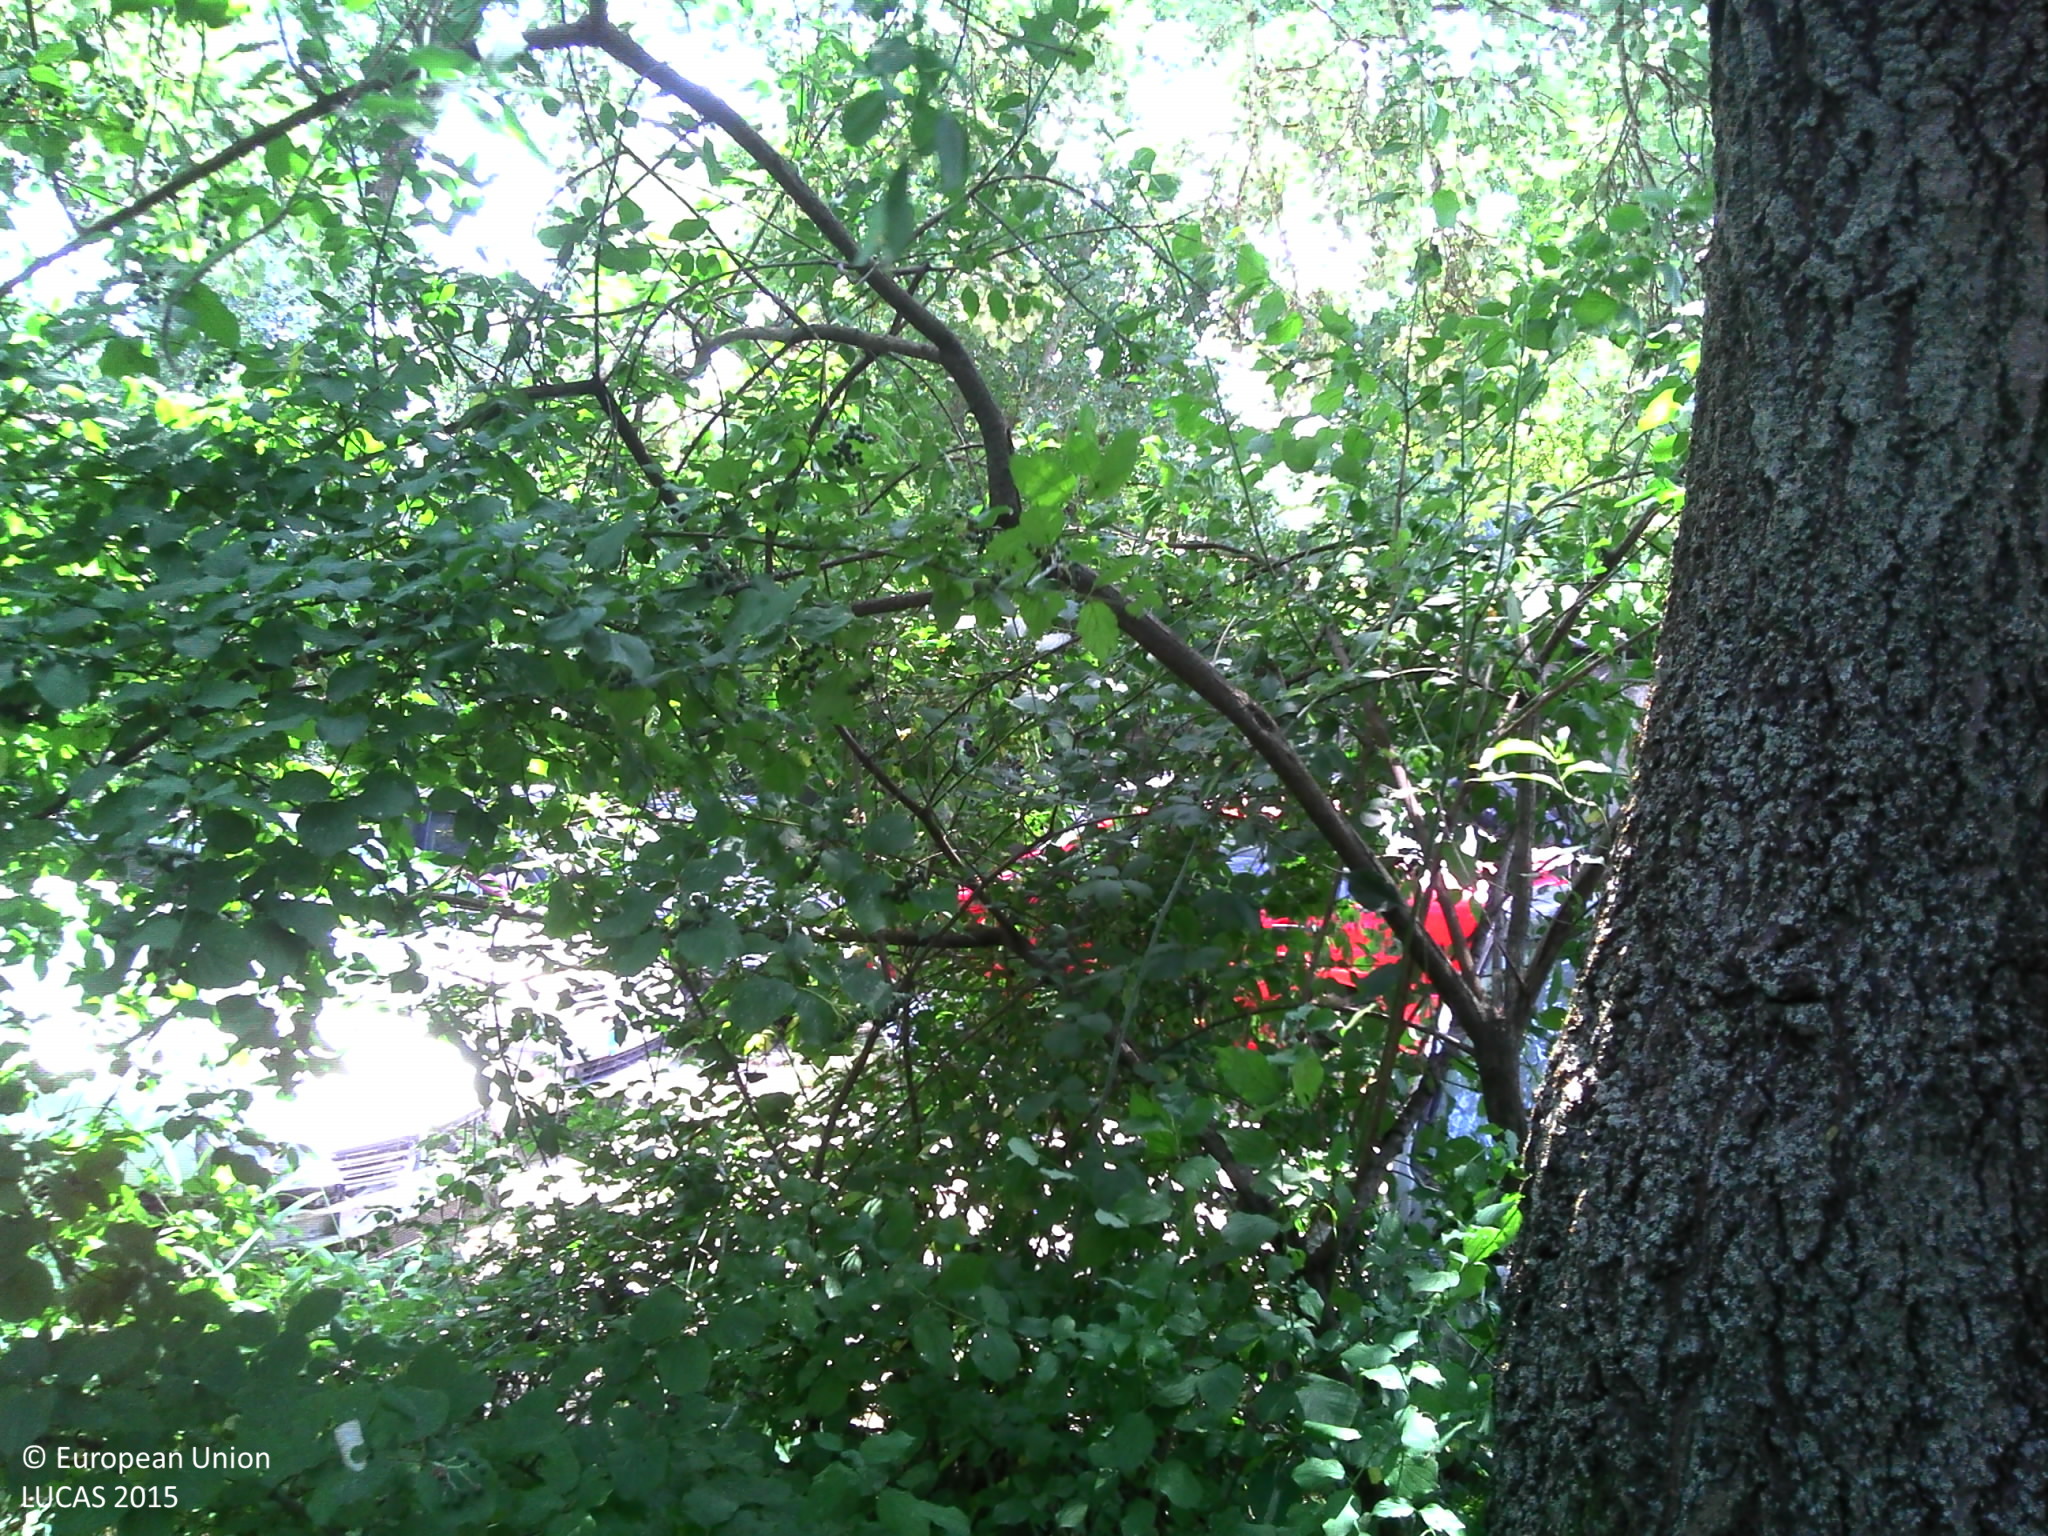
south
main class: Woodland
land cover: Broadleaved woodland
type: floodplain forest
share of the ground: 50 - 75 %
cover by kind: broadleaved forest trees 60 %, shrubs 20 %, coniferous forest trees 10 %, herbaceous plants 10 %
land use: Semi-natural and natural areas not in use
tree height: > 5 m
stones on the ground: < 10 %
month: July
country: FR
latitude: 44.2518
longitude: 4.7100
